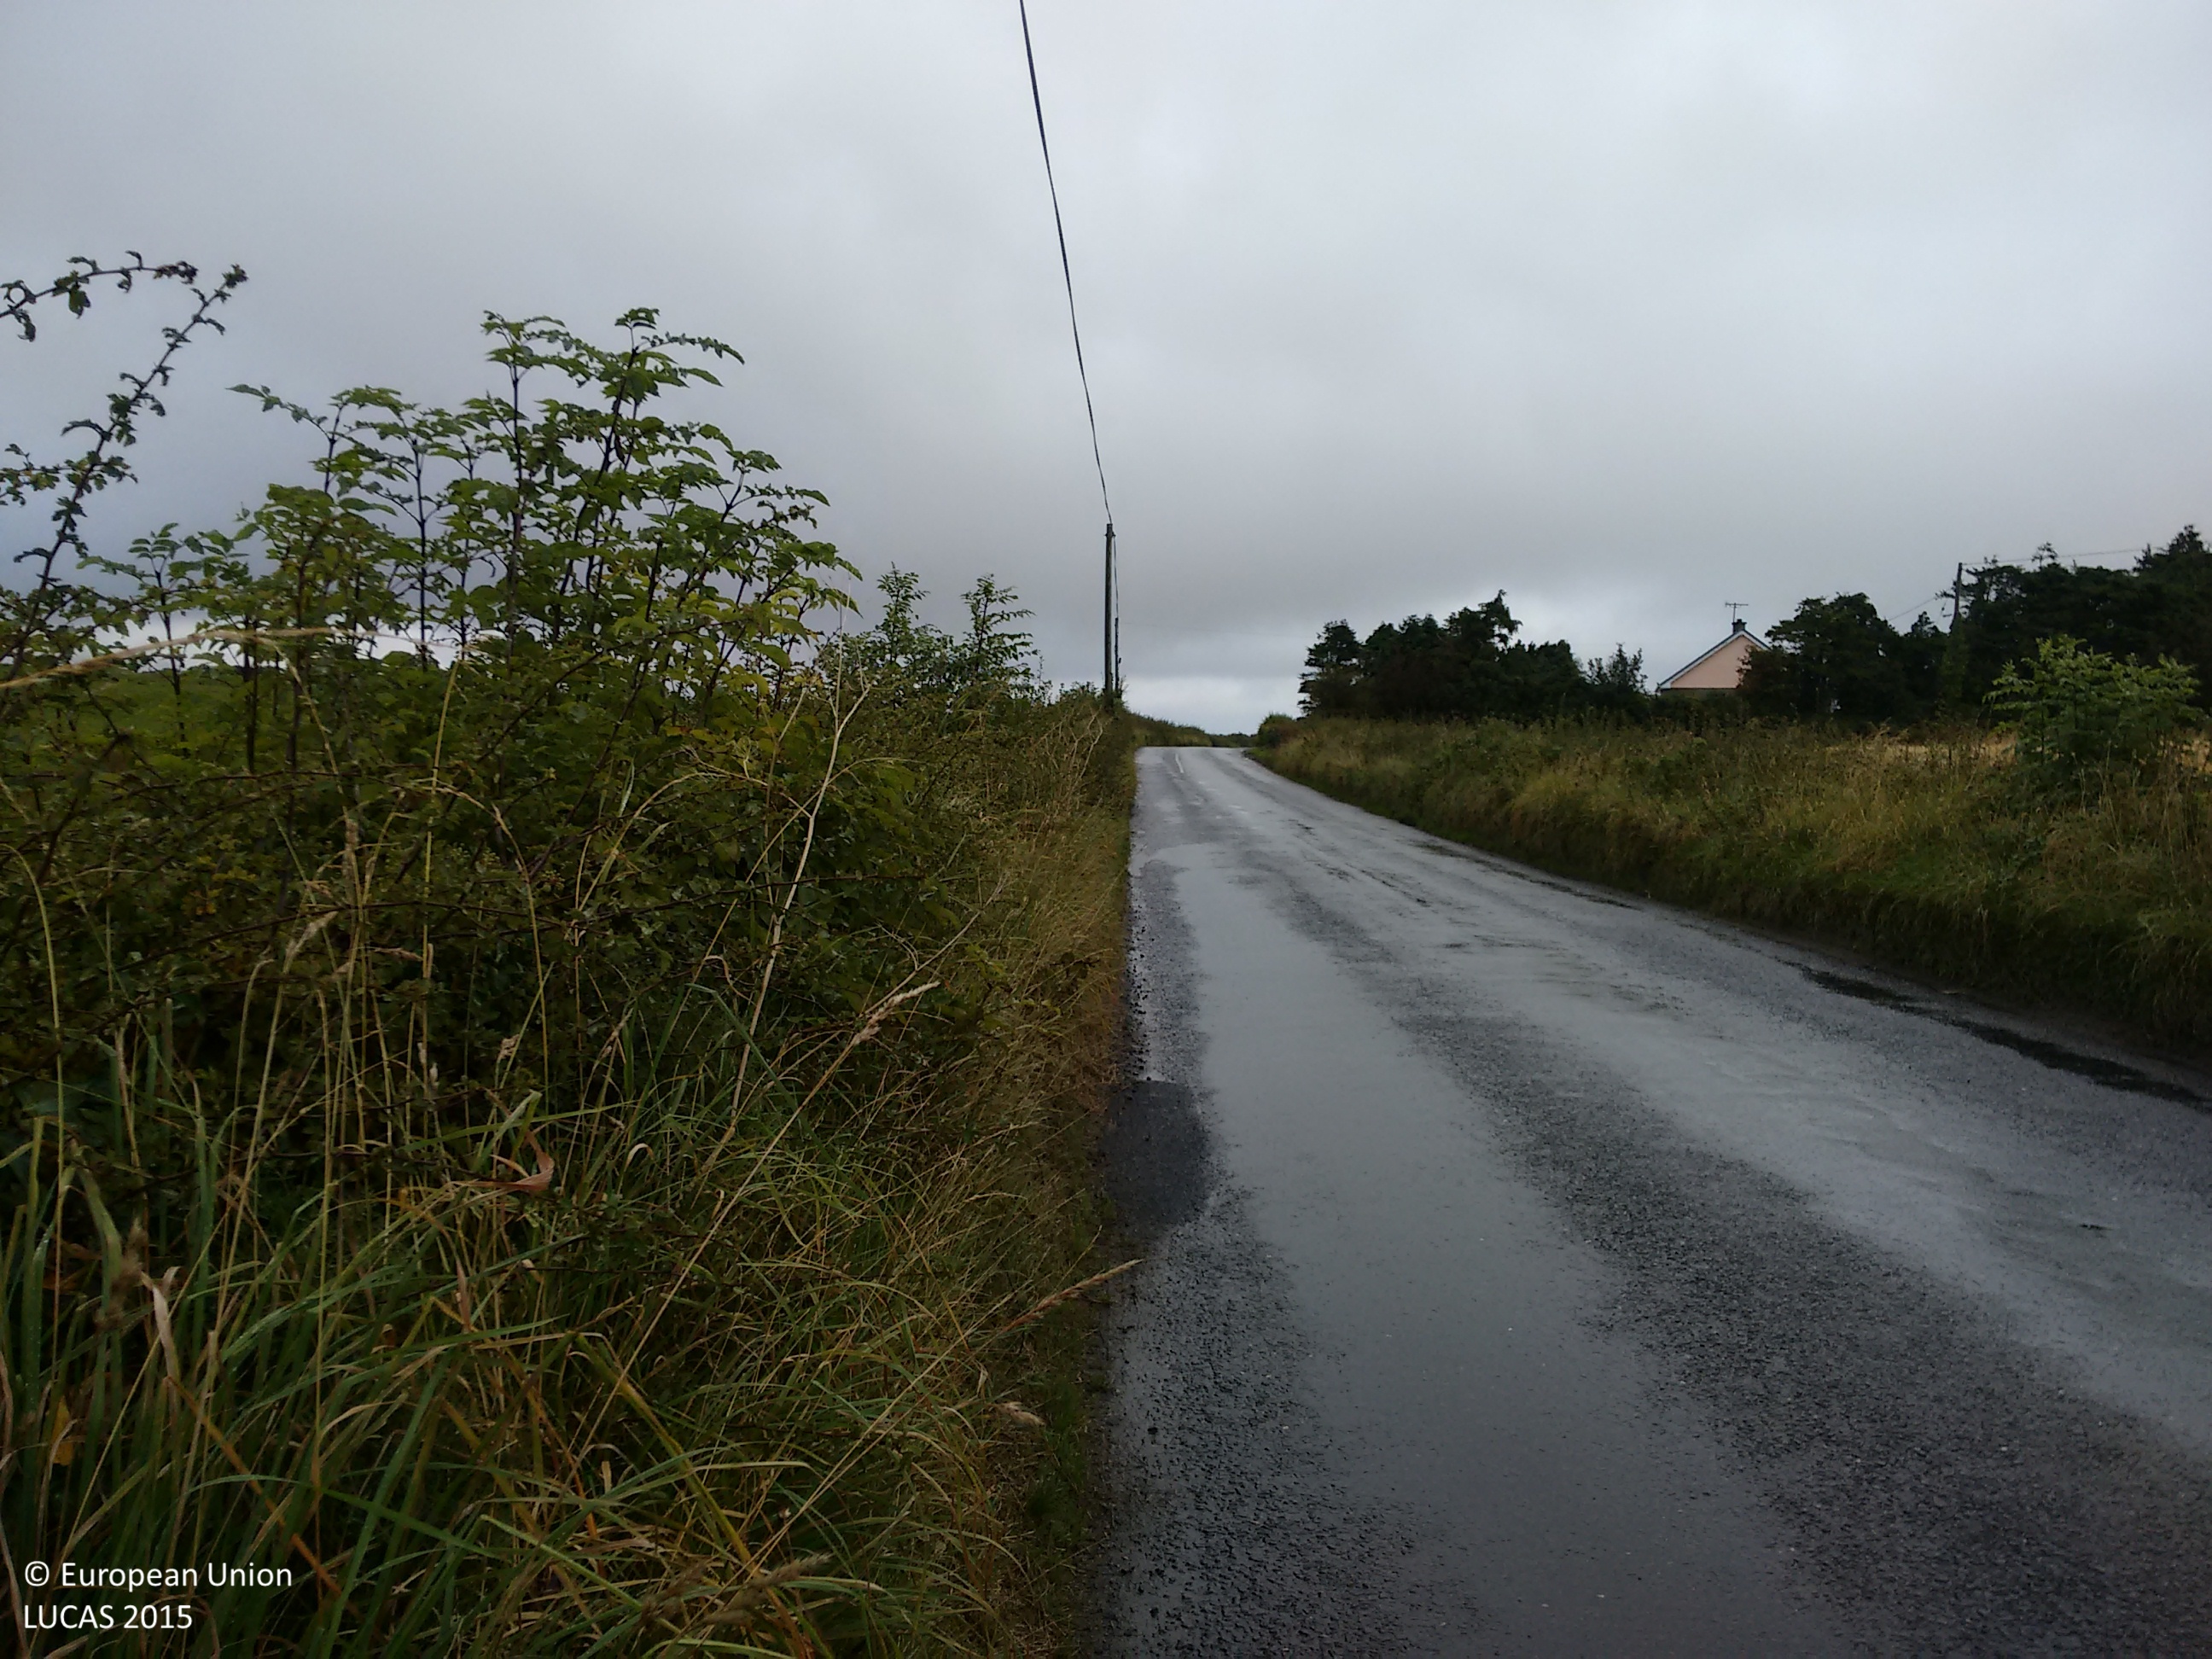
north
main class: Grassland
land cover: Grassland without tree/shrub cover
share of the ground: > 75 %
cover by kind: herbaceous plants 100 %
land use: Agriculture (excluding fallow land and kitchen gardens)
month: September
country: IE
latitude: 54.9604
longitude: -7.5702
